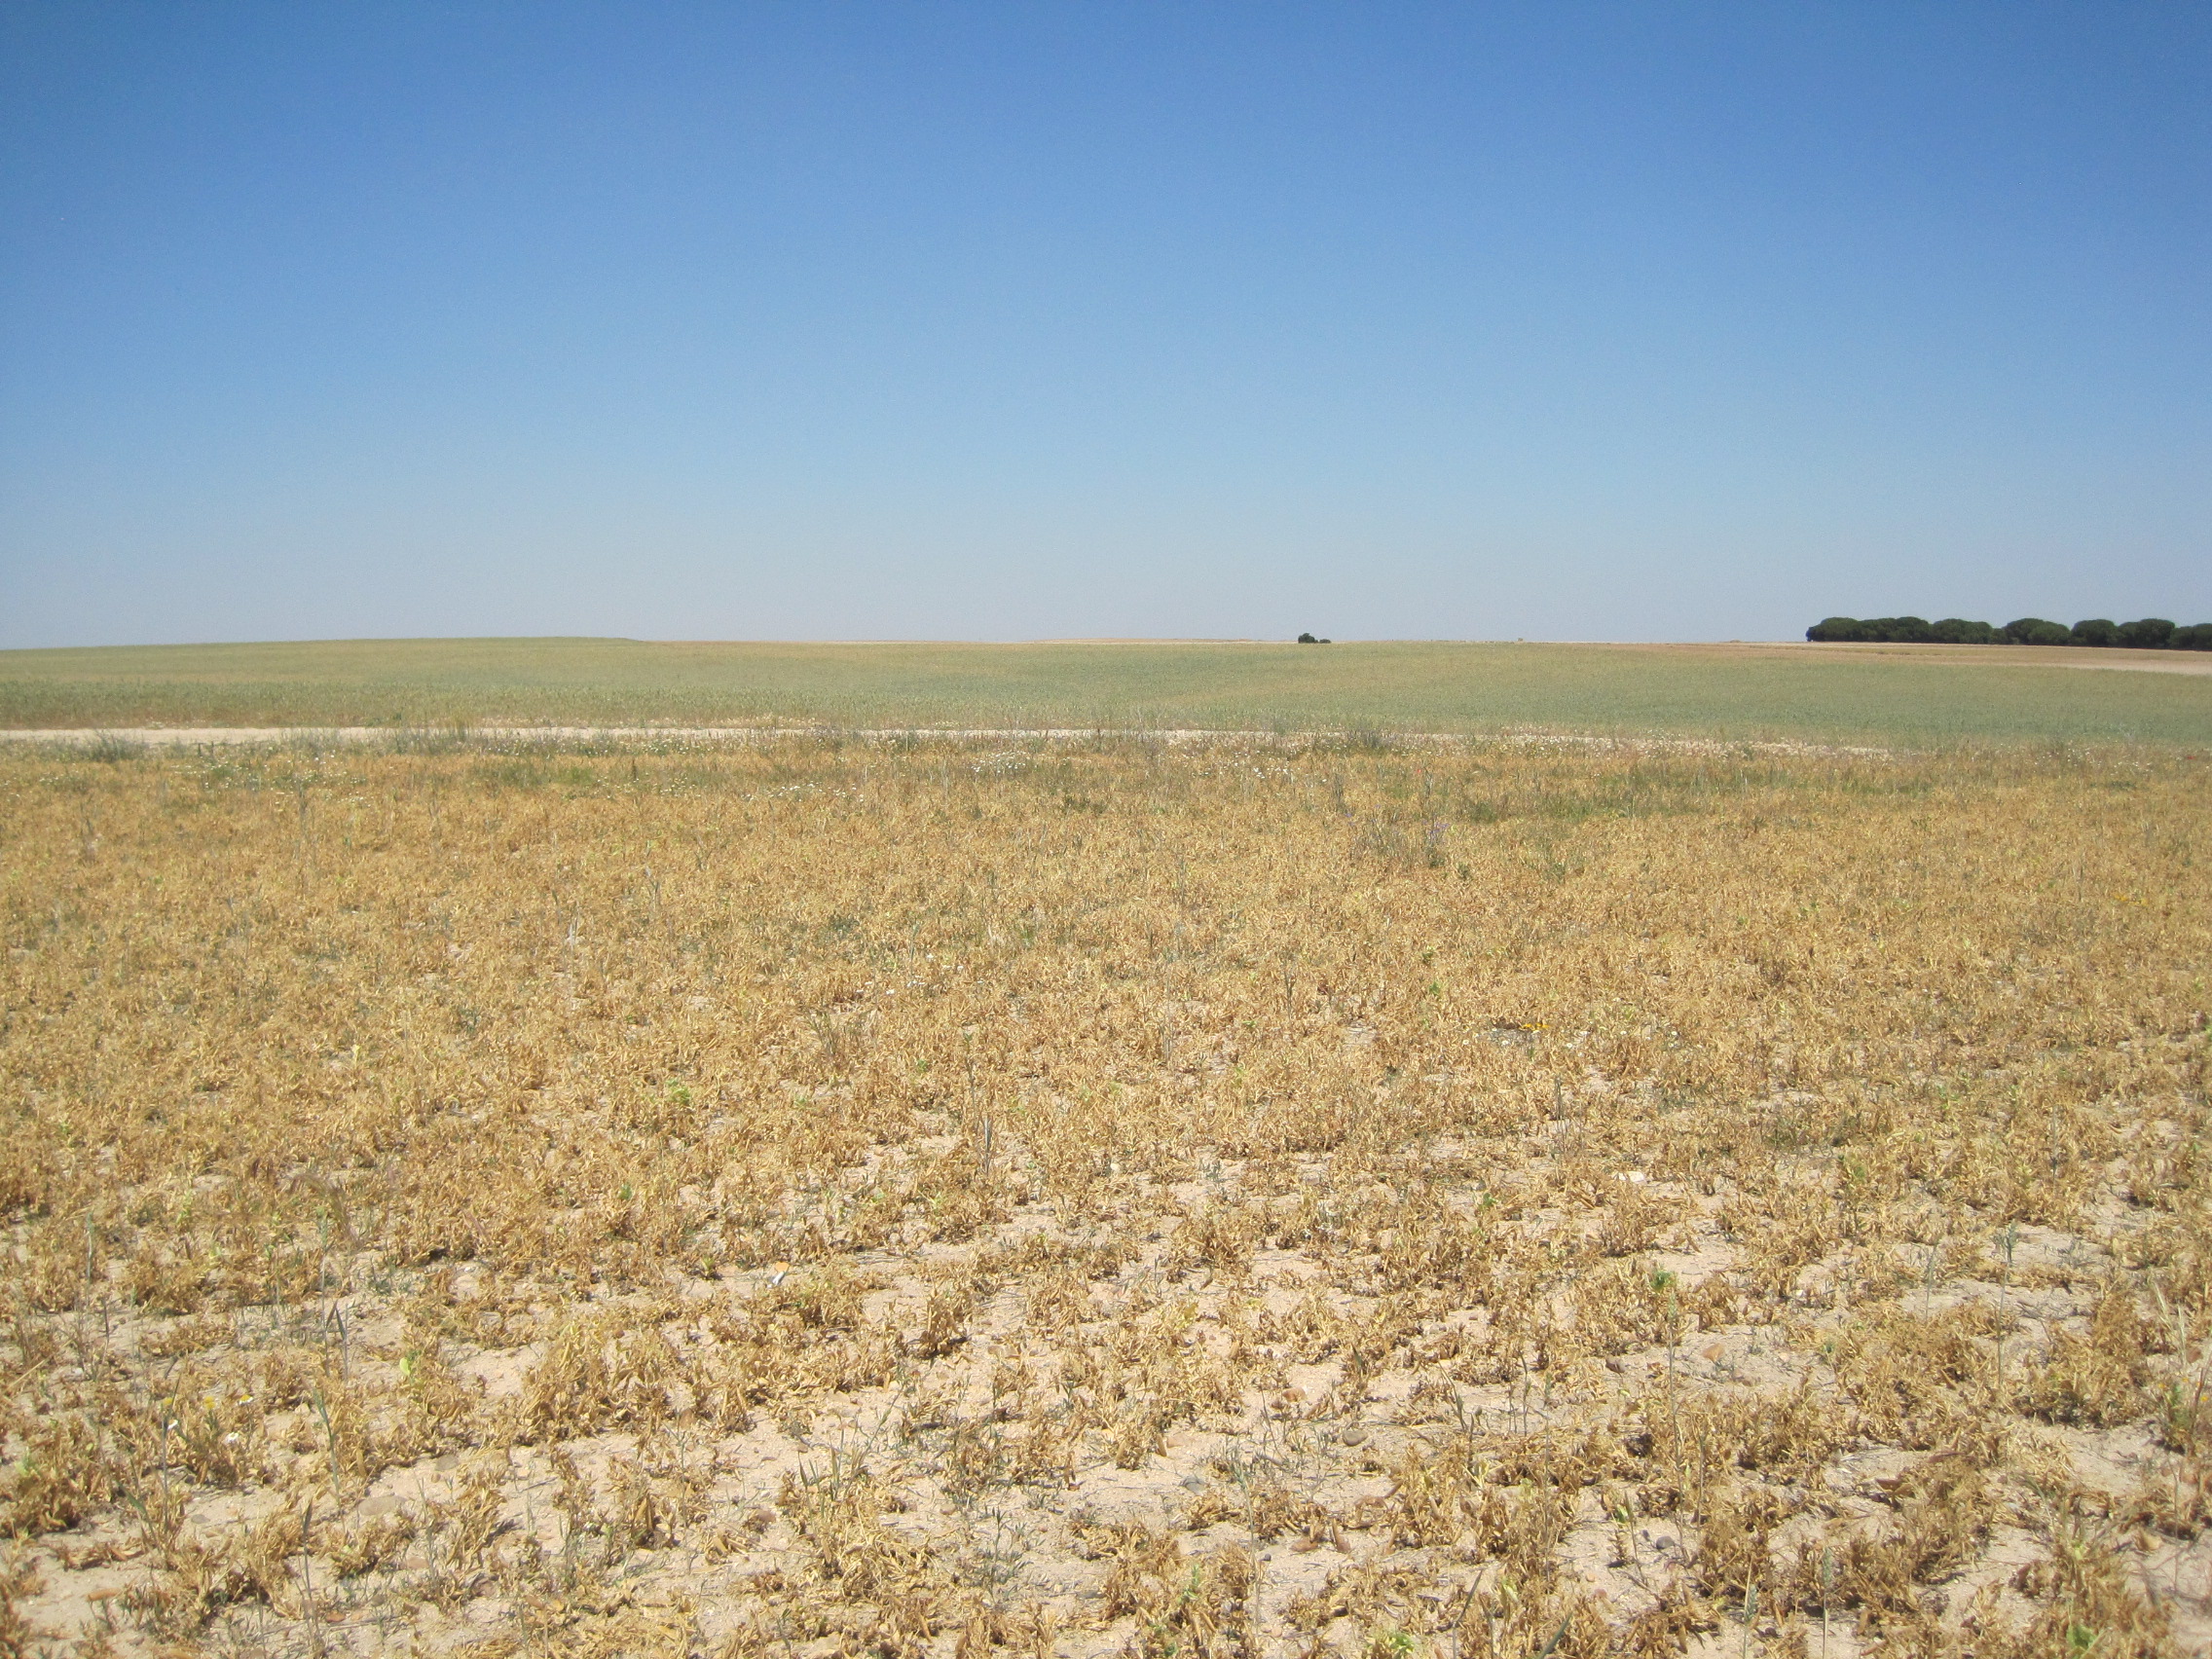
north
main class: Cropland
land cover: Dry pulses
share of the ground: > 75 %
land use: Agriculture (excluding fallow land and kitchen gardens)
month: May
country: ES
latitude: 41.2758
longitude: -5.1013
